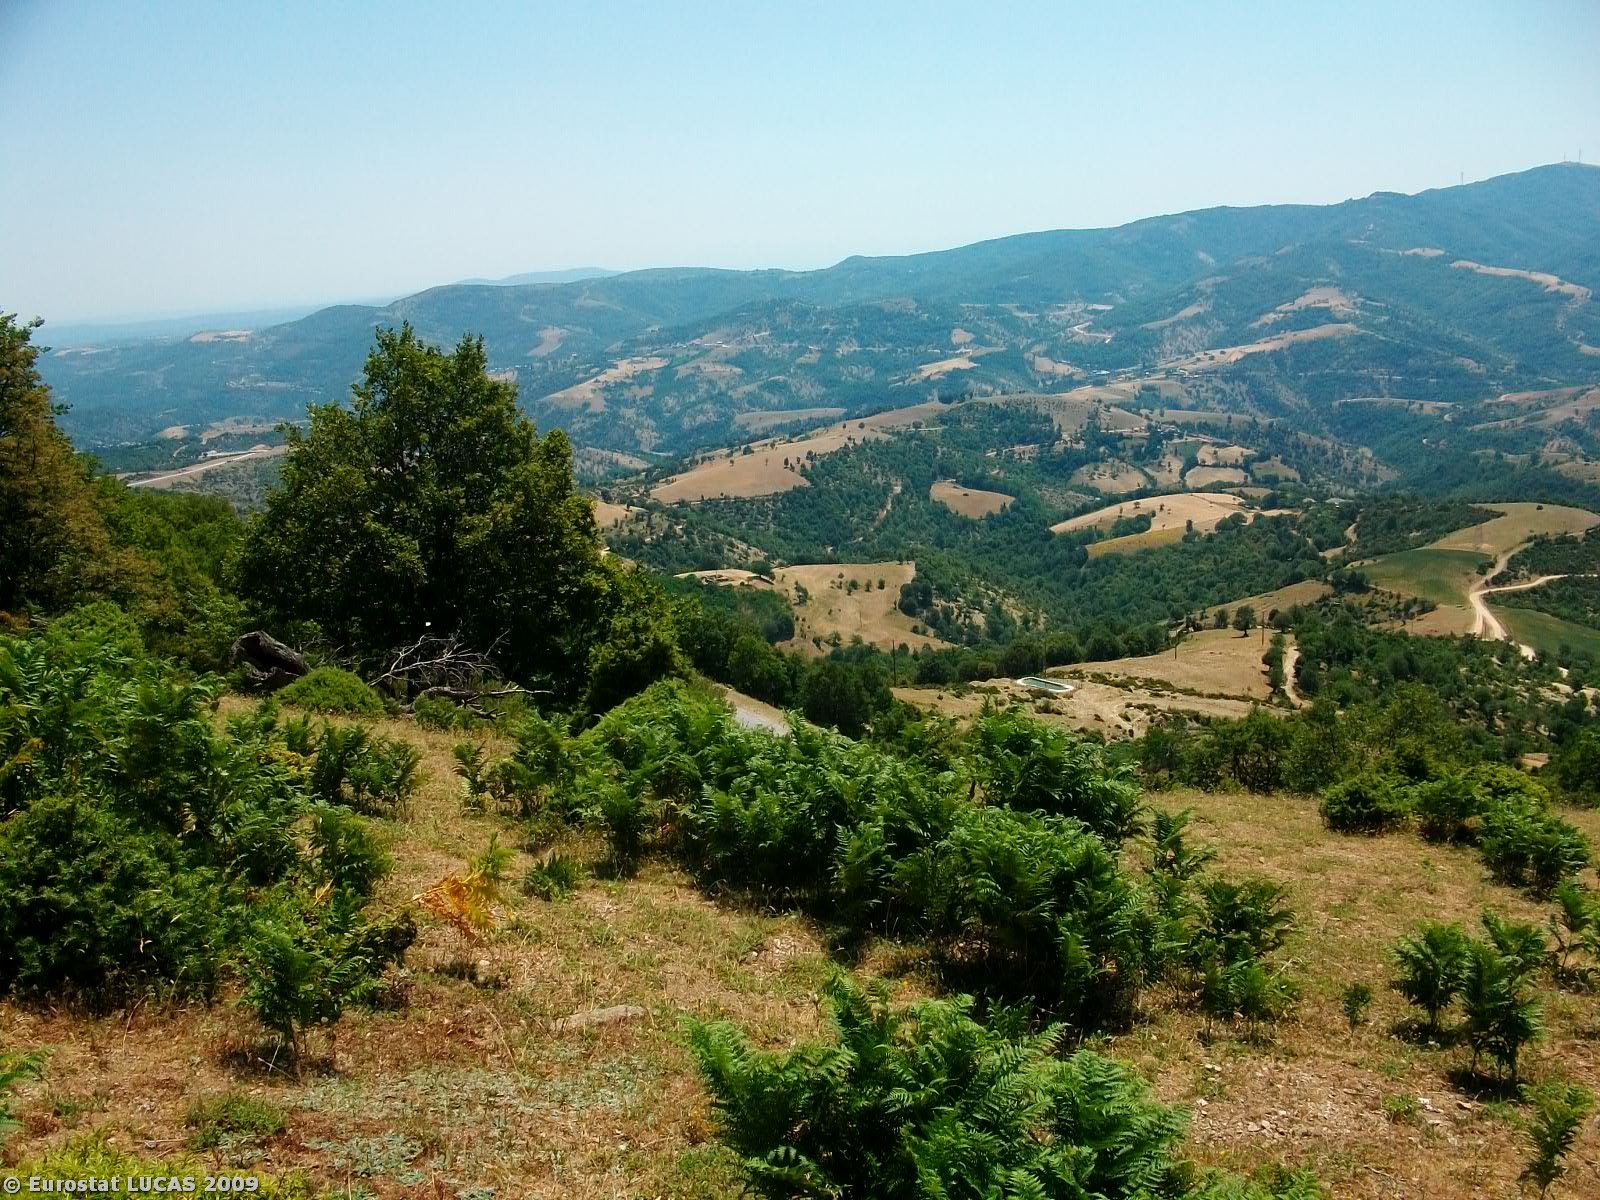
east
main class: Shrubland
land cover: Shrubland without tree cover
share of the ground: > 75 %
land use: Agriculture (excluding fallow land and kitchen gardens)
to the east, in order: Shrubland without tree cover; Electric lines; Grassland with sparse tree/shrub cover; Paved roads, cycling and walking lanes; Broadleaved woodland; Bare land; Paved roads, cycling and walking lanes; Grass margins; Broadleaved woodland; Electric lines; Broadleaved woodland; Grassland with sparse tree/shrub cover
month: June
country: GR
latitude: 41.2108
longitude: 25.8636
